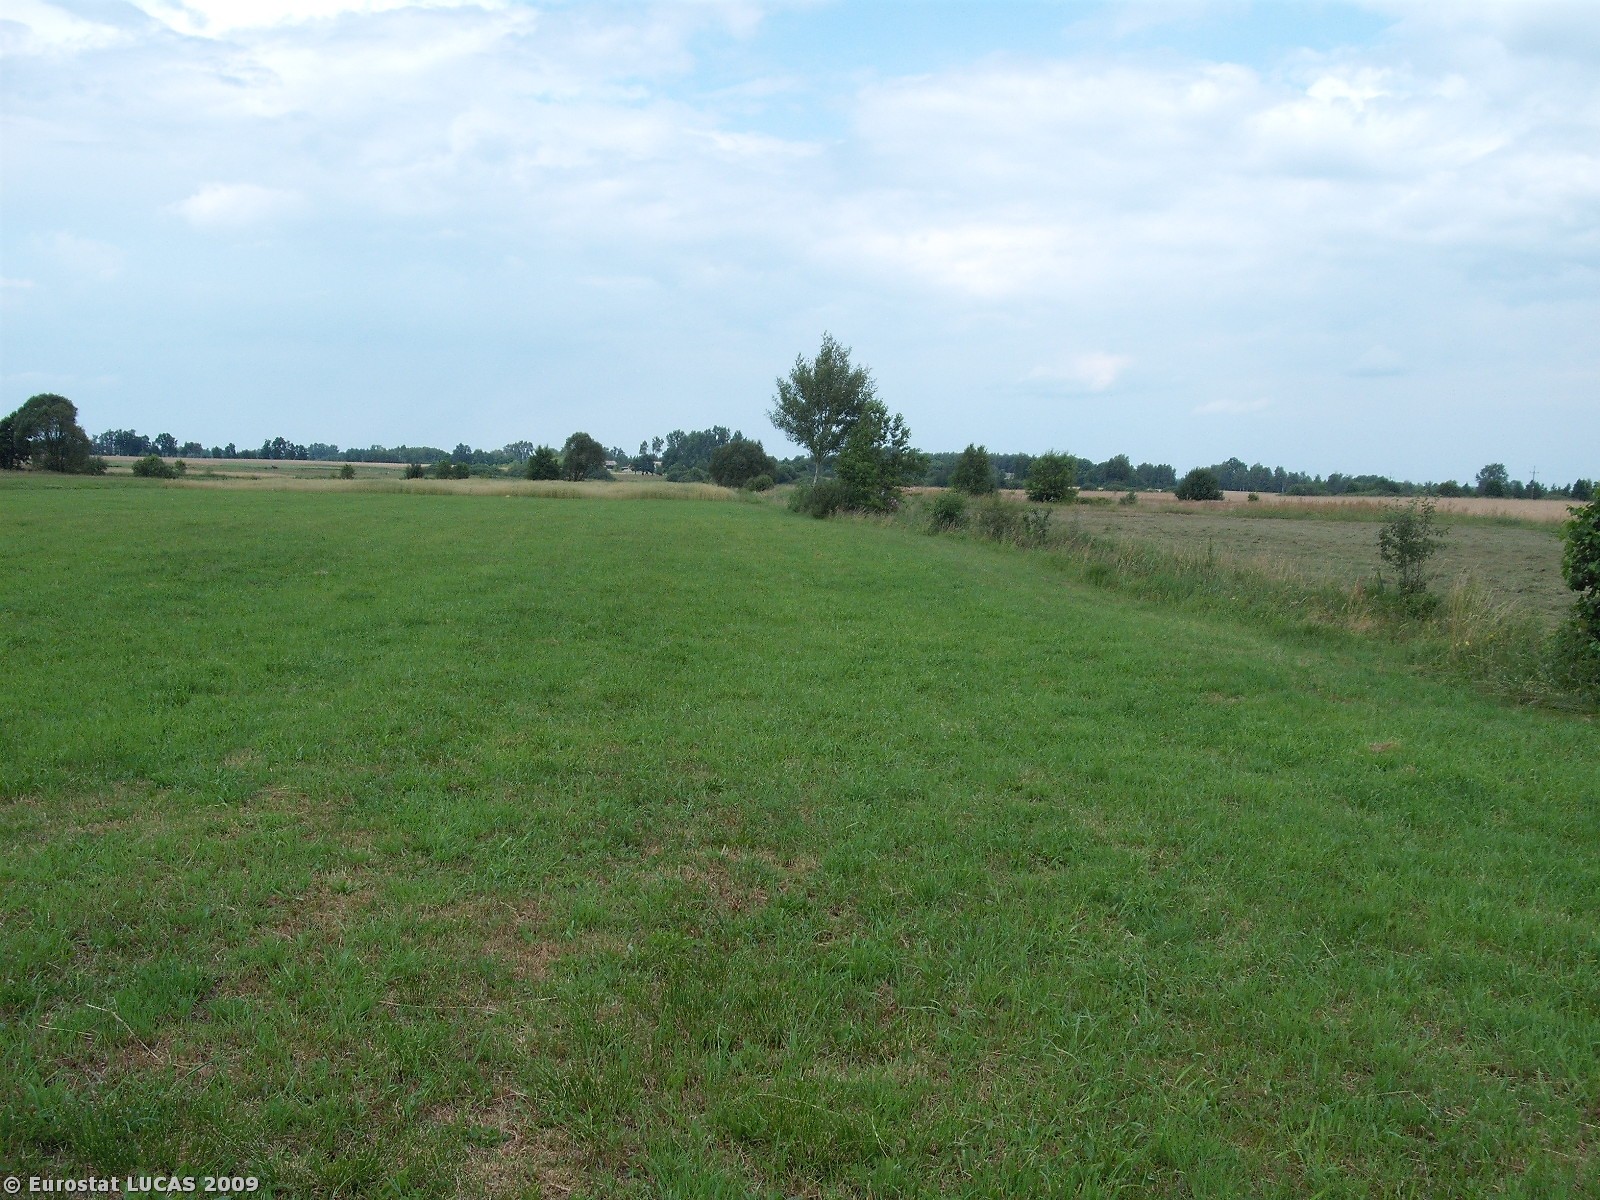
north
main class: Grassland
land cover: Grassland without tree/shrub cover
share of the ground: > 75 %
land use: Agriculture (excluding fallow land and kitchen gardens)
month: July
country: PL
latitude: 51.5487
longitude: 21.0775
